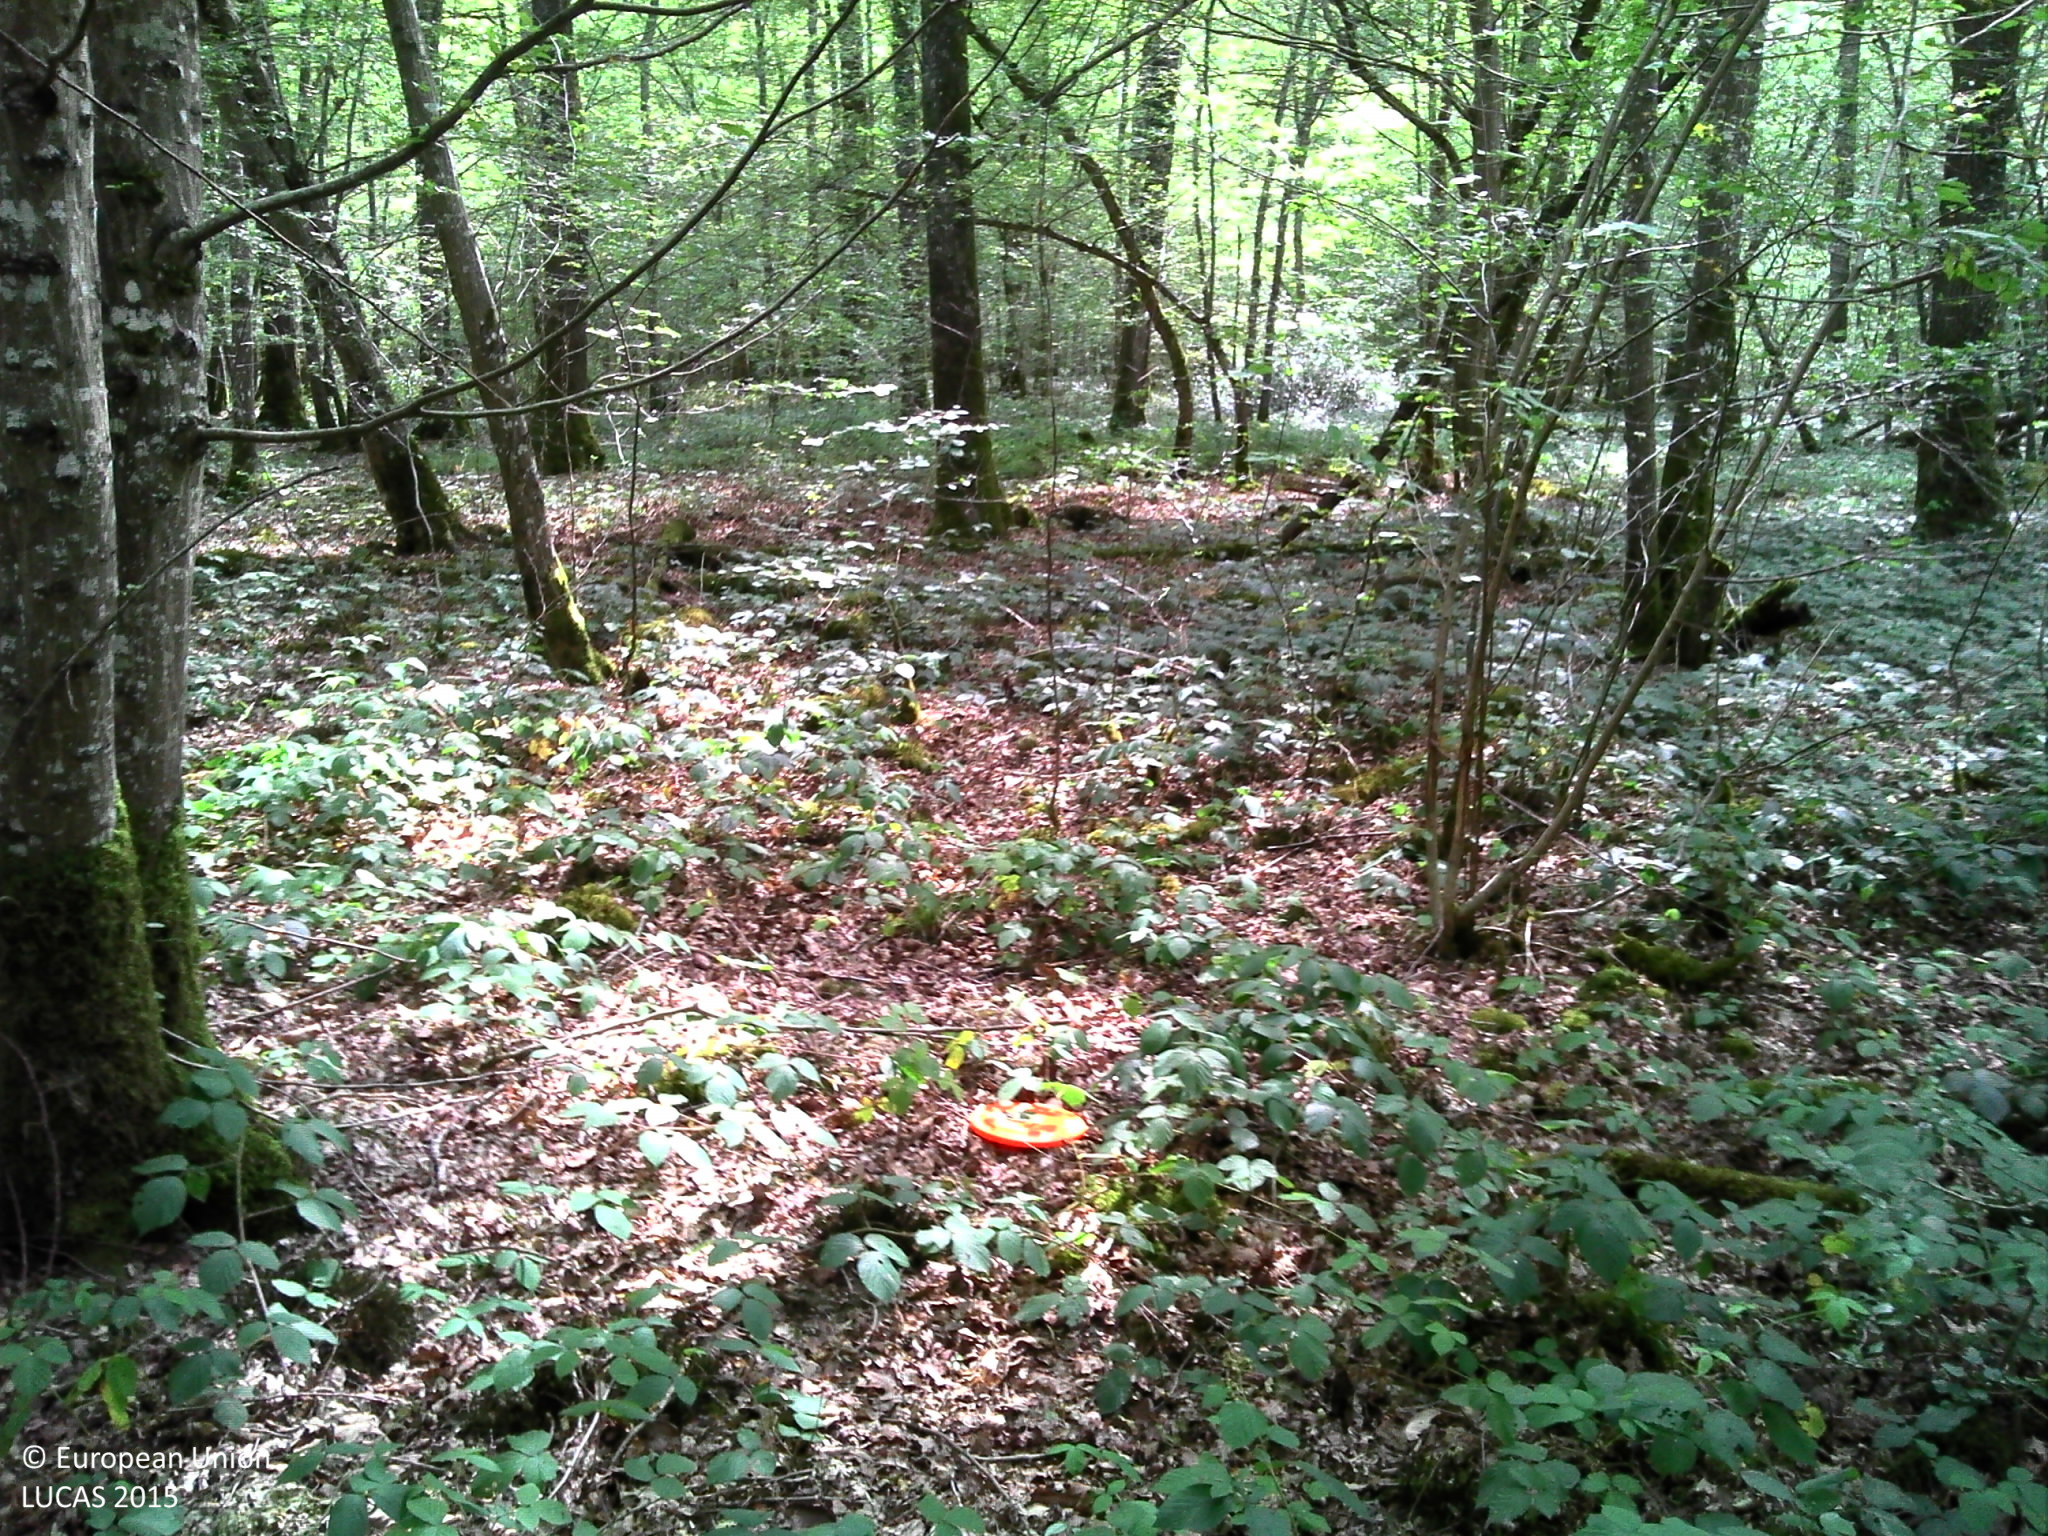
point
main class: Woodland
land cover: Broadleaved woodland
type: mesophytic deciduous forest
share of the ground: > 75 %
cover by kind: broadleaved forest trees 90 %, herbaceous plants 5 %, lichens and mosses 5 %
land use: Forestry
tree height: > 5 m
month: July
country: FR
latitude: 48.0766
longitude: 3.0536
